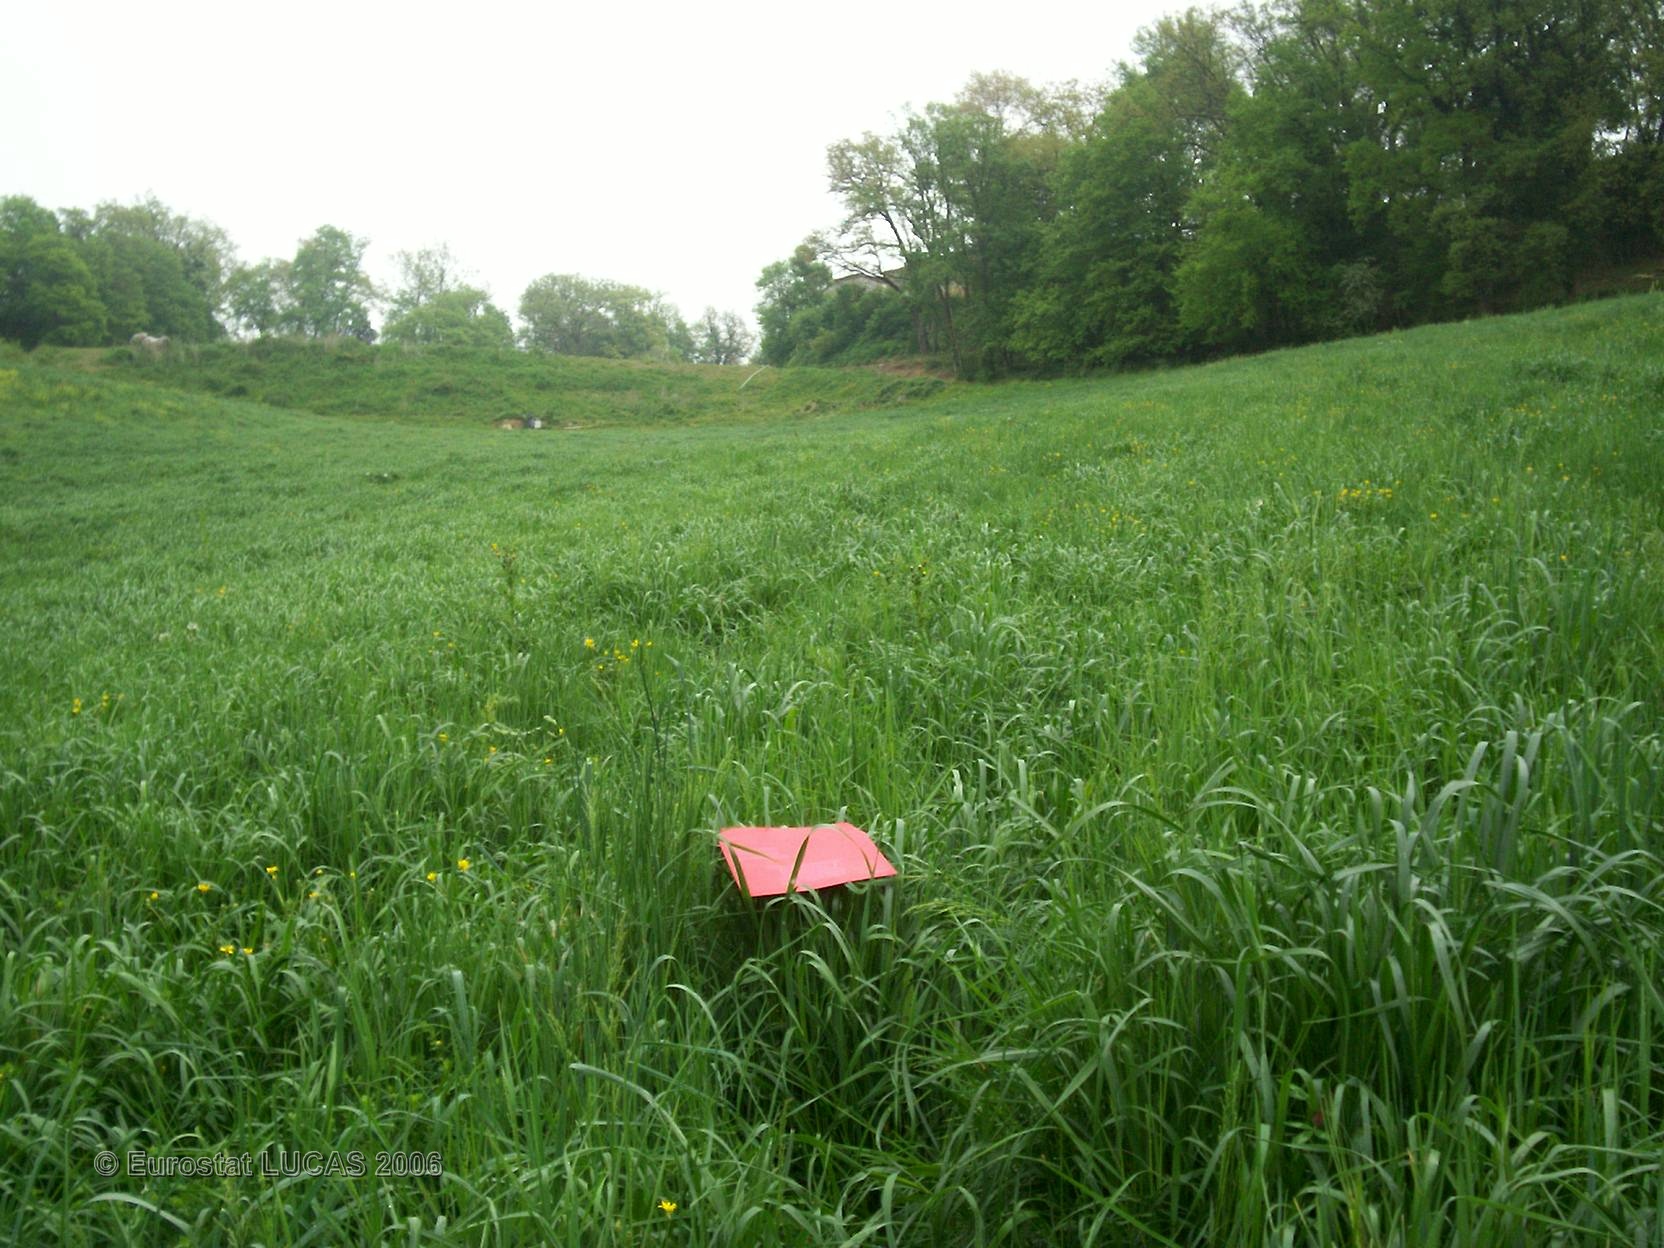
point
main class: Grassland
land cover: Grassland without tree/shrub cover
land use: Agriculture (excluding fallow land and kitchen gardens)
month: April
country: FR
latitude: 44.2196
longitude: 0.8712
